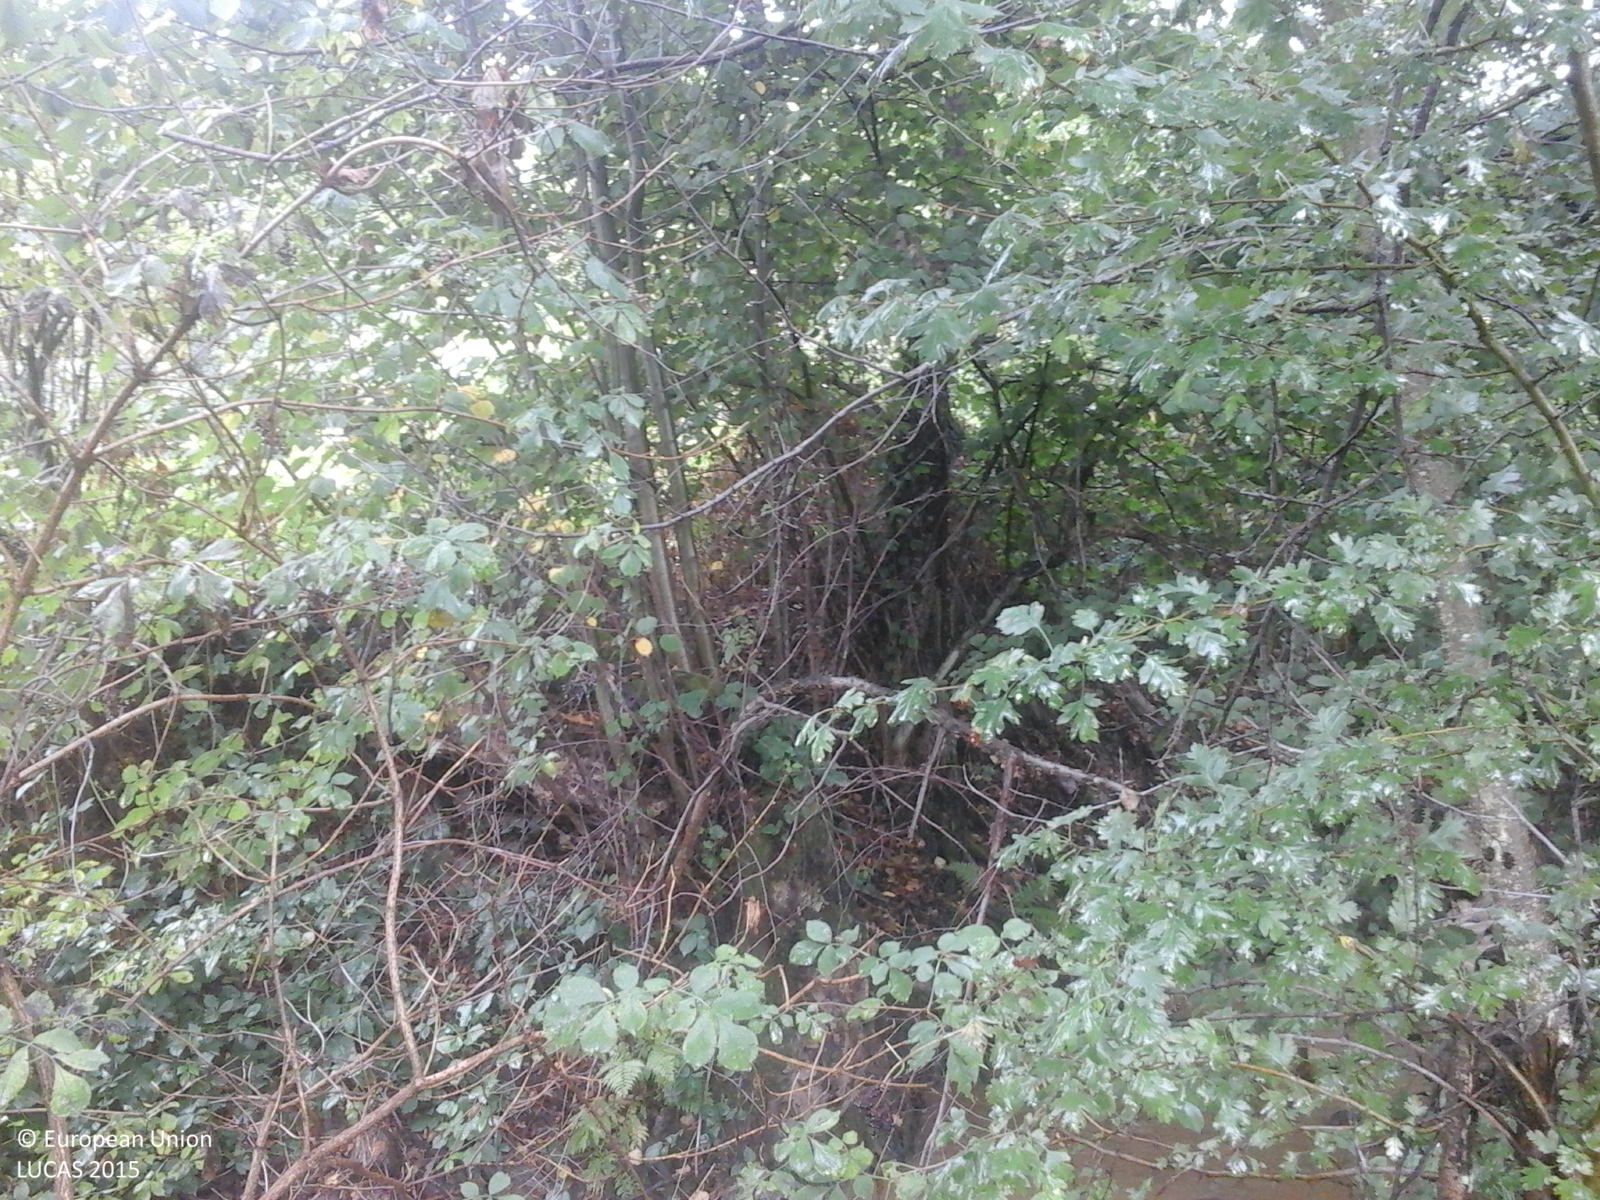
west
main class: Woodland
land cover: Broadleaved woodland
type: thermophilous deciduous forest
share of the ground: > 75 %
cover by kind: broadleaved forest trees 100 %
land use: Forestry
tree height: > 5 m
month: August
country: RO
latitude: 44.9999
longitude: 22.1522
